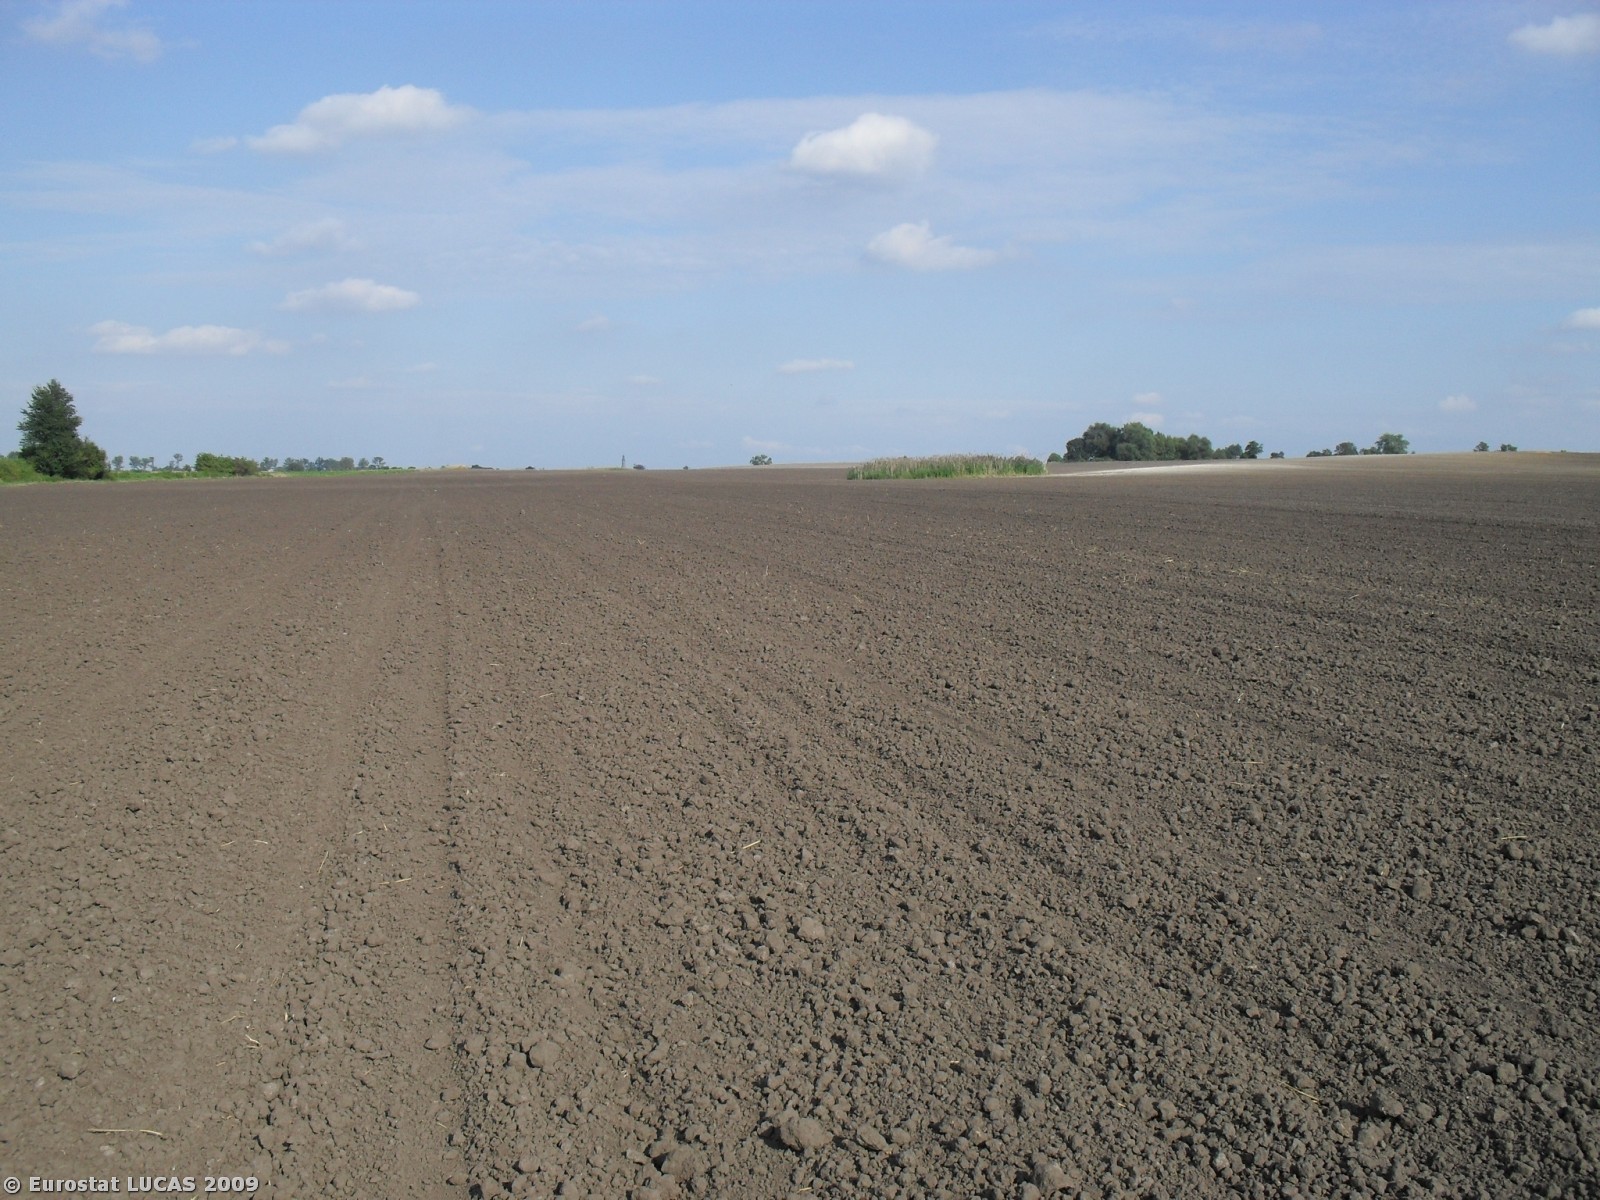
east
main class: Cropland
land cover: Common wheat
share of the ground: < 10 %
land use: Agriculture (excluding fallow land and kitchen gardens)
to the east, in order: Common wheat
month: September
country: PL
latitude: 50.8208
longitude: 17.2365
